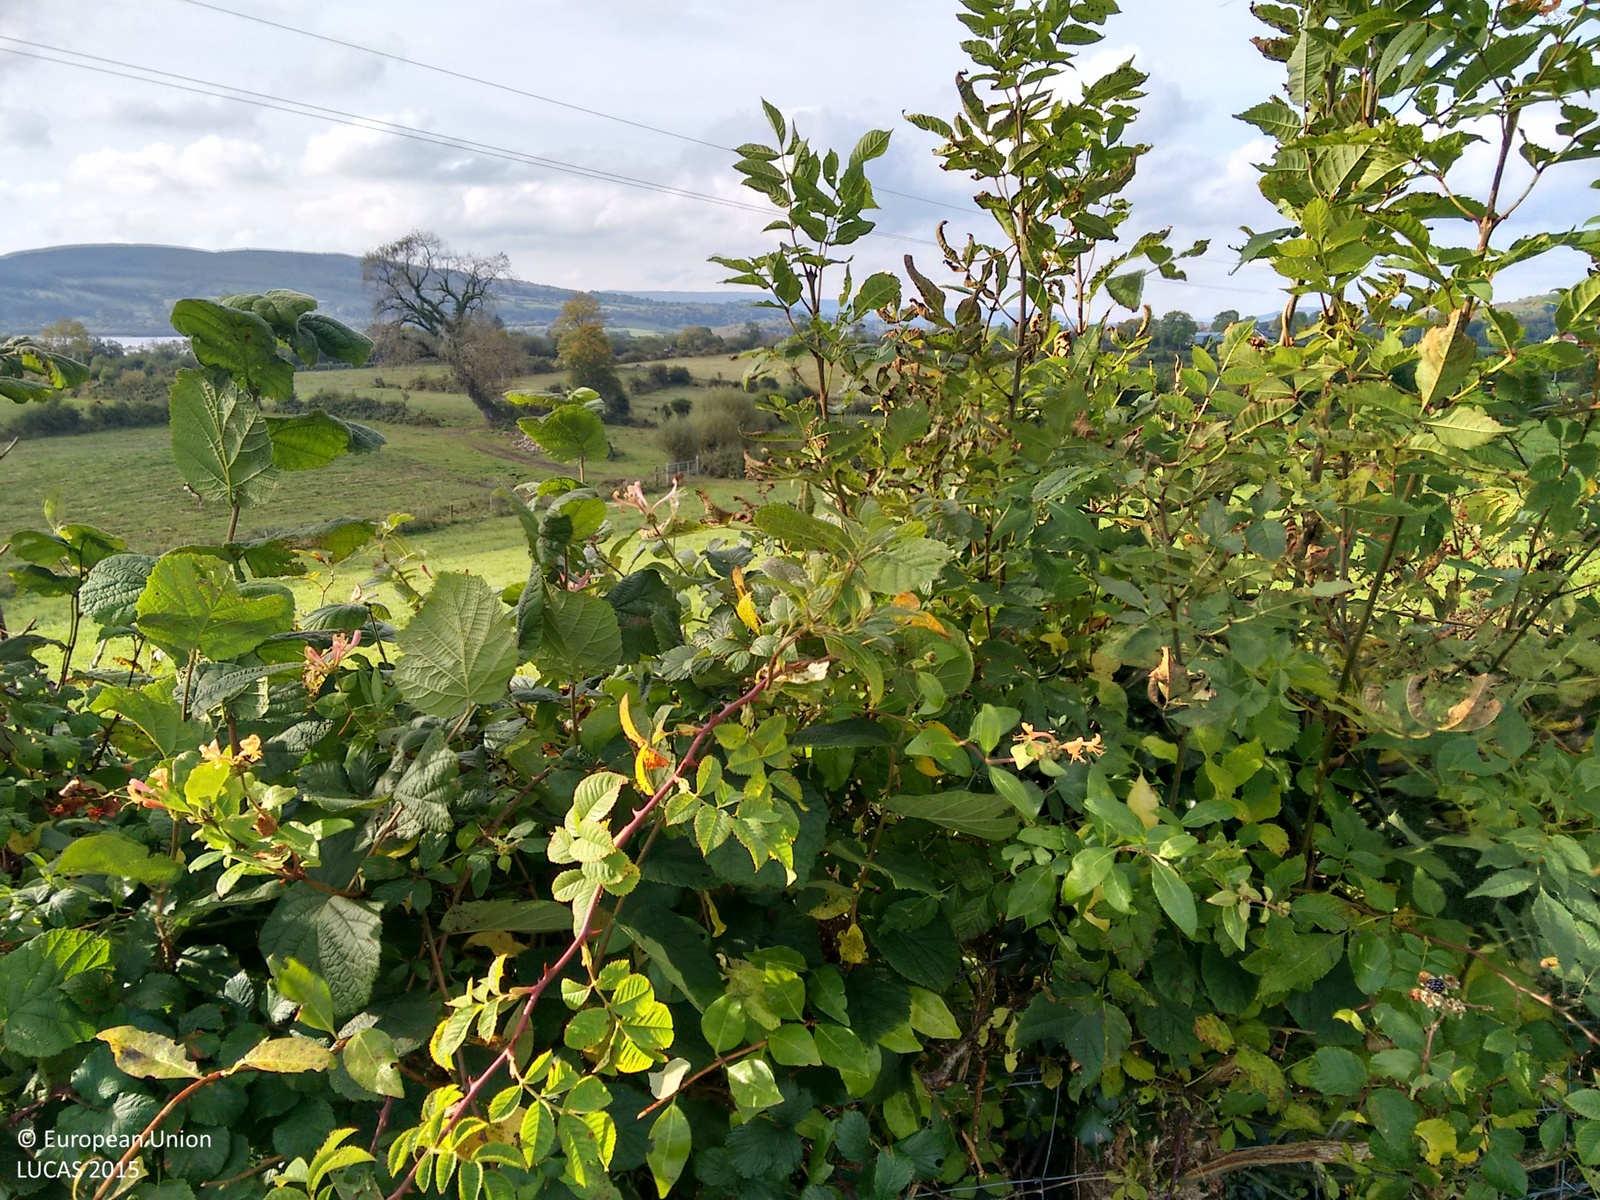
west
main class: Grassland
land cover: Grassland without tree/shrub cover
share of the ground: > 75 %
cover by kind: herbaceous plants 100 %
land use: Agriculture (excluding fallow land and kitchen gardens)
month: October
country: GB
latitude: 54.2963
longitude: -7.8217
